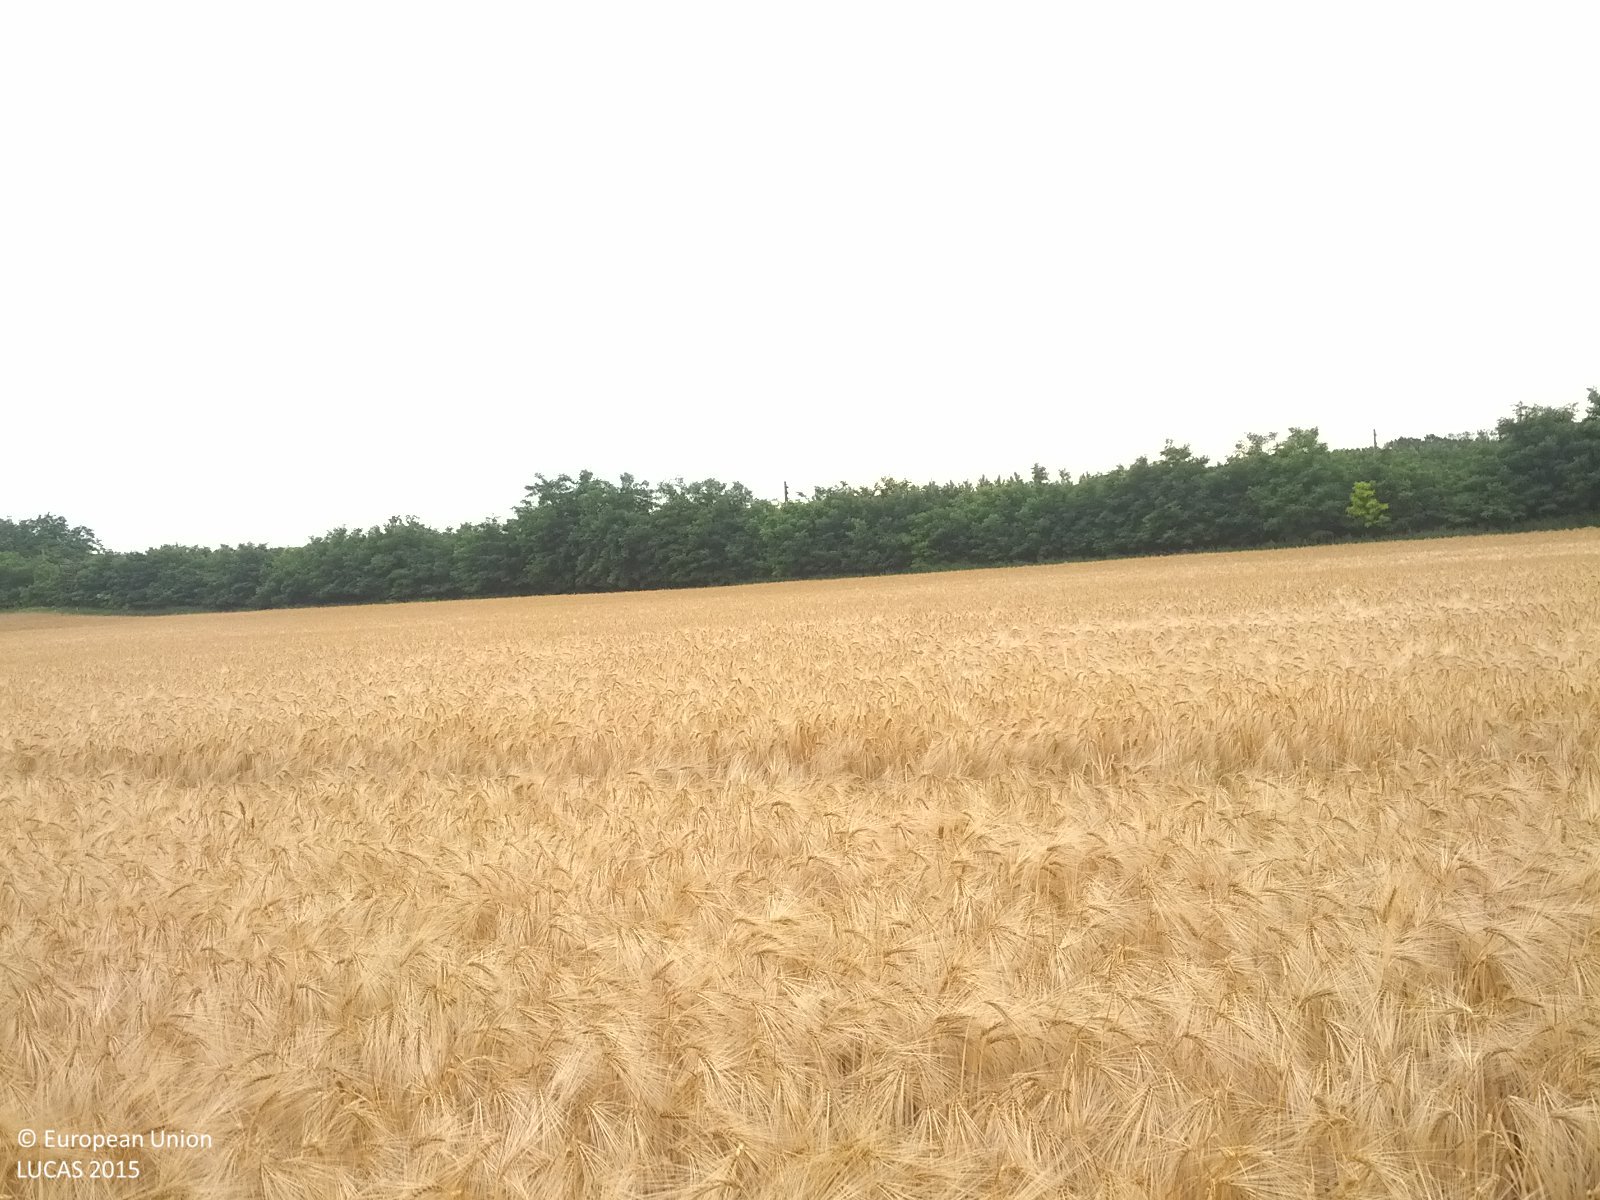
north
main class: Cropland
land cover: Barley
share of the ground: > 75 %
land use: Agriculture (excluding fallow land and kitchen gardens)
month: June
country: AT
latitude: 48.2607
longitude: 16.8906
